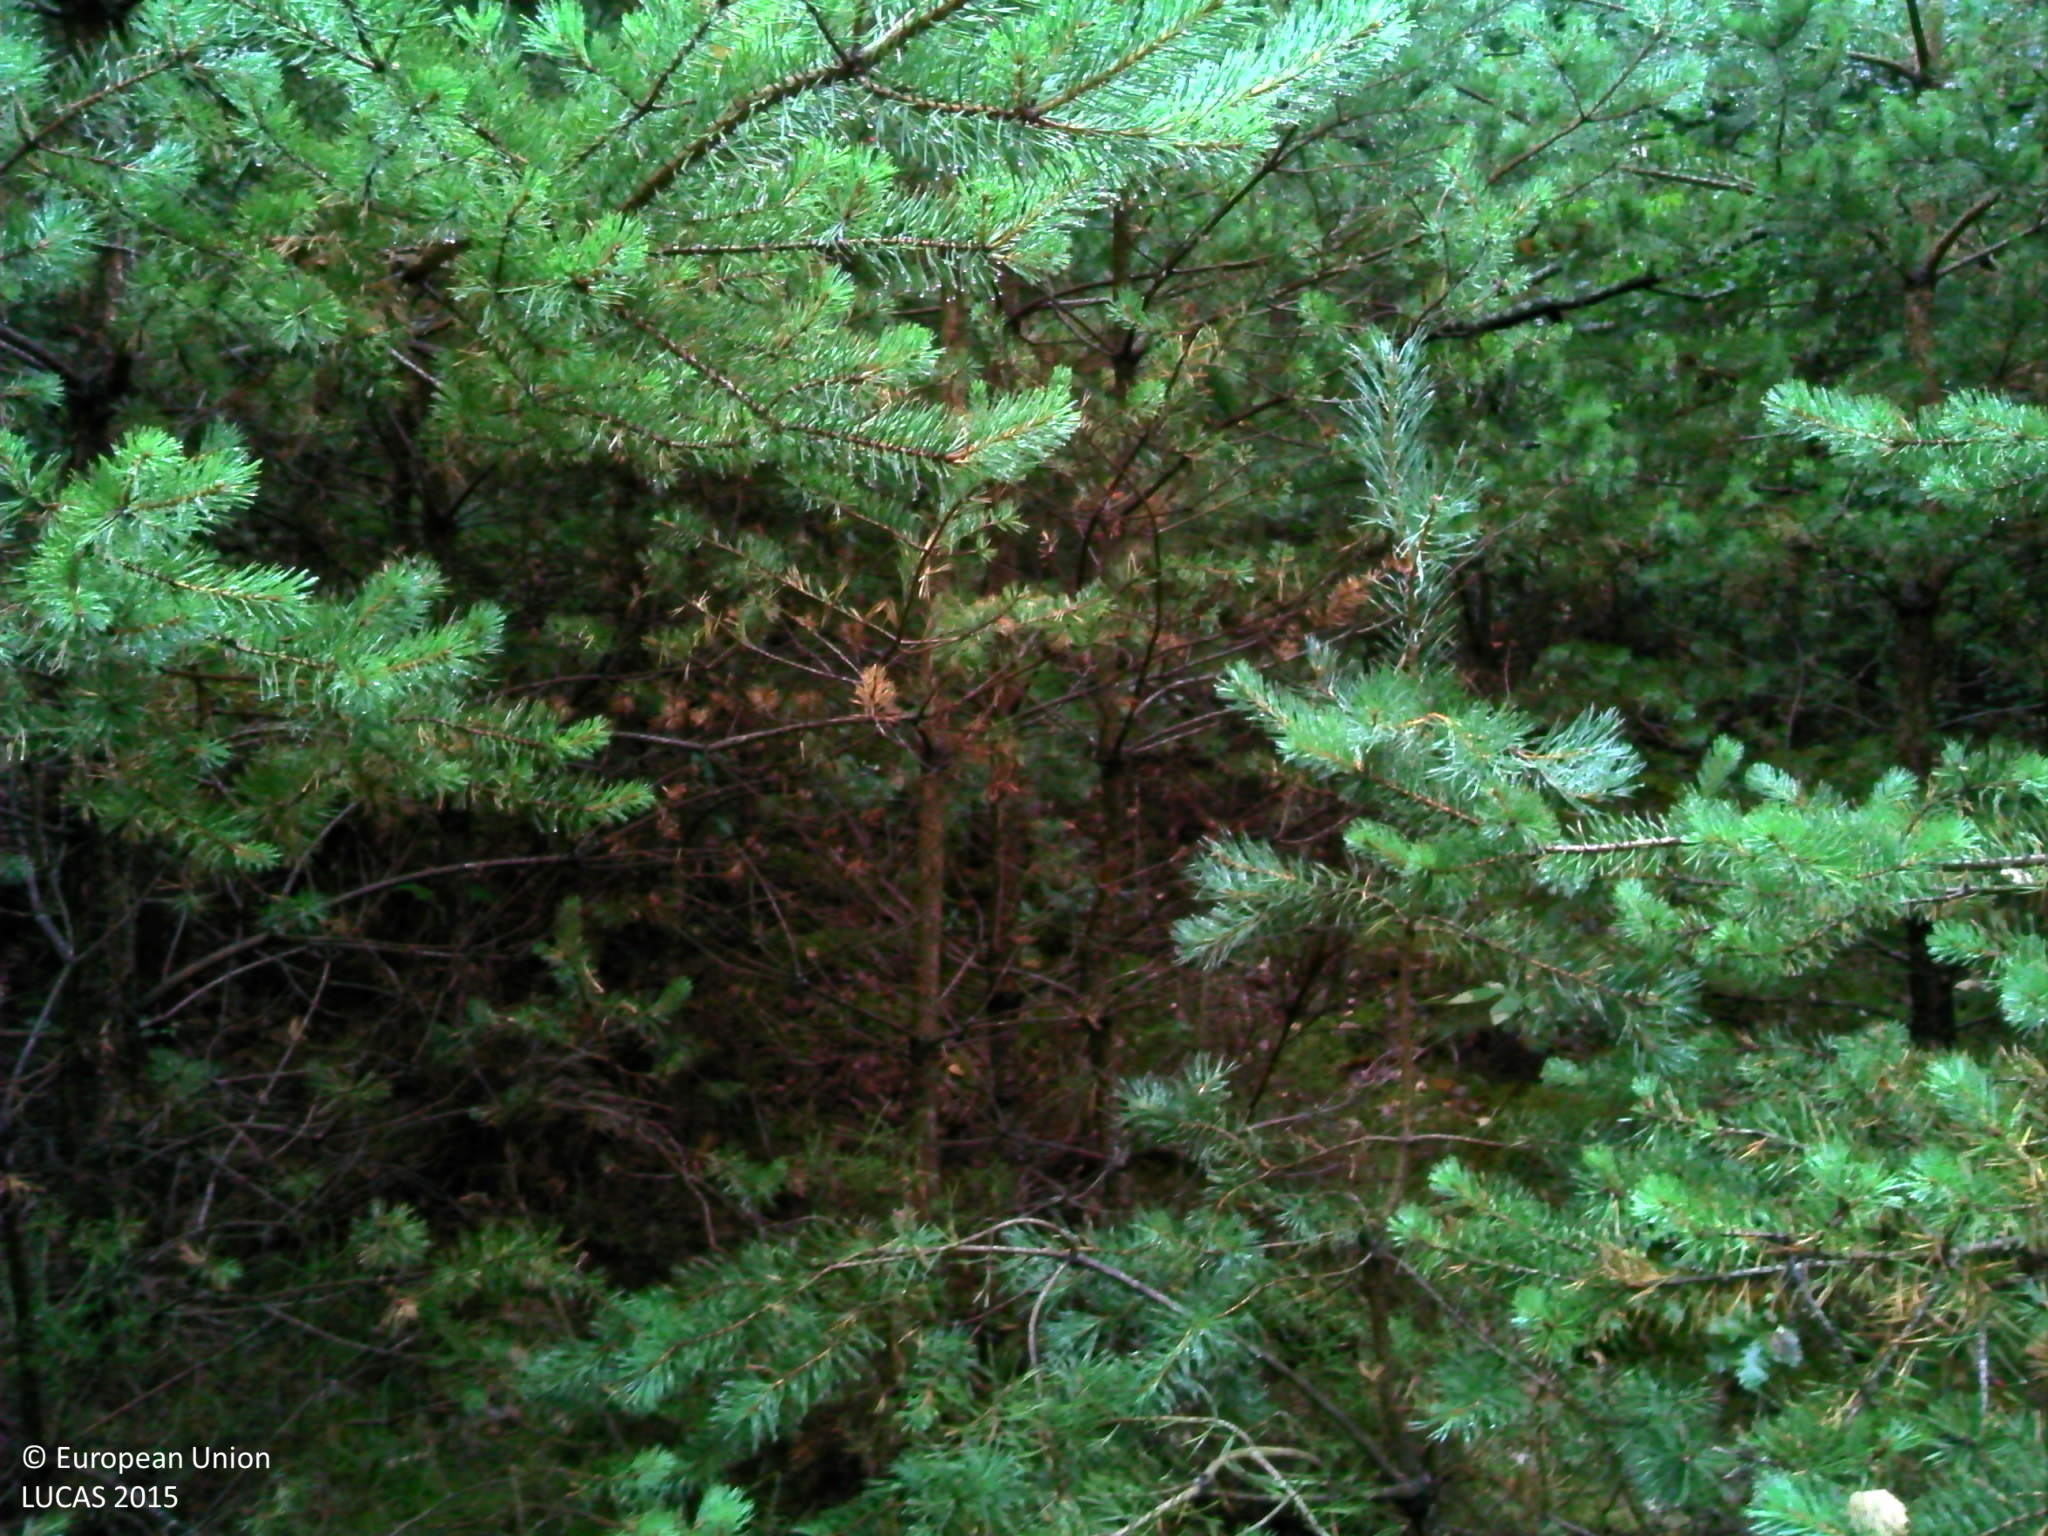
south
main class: Woodland
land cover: Broadleaved woodland
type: thermophilous deciduous forest
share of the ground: > 75 %
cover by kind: broadleaved forest trees 65 %, coniferous forest trees 10 %, shrubs 10 %, lichens and mosses 10 %, herbaceous plants 5 %
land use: Forestry
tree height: > 5 m
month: July
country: FR
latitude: 45.4691
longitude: 4.1580
